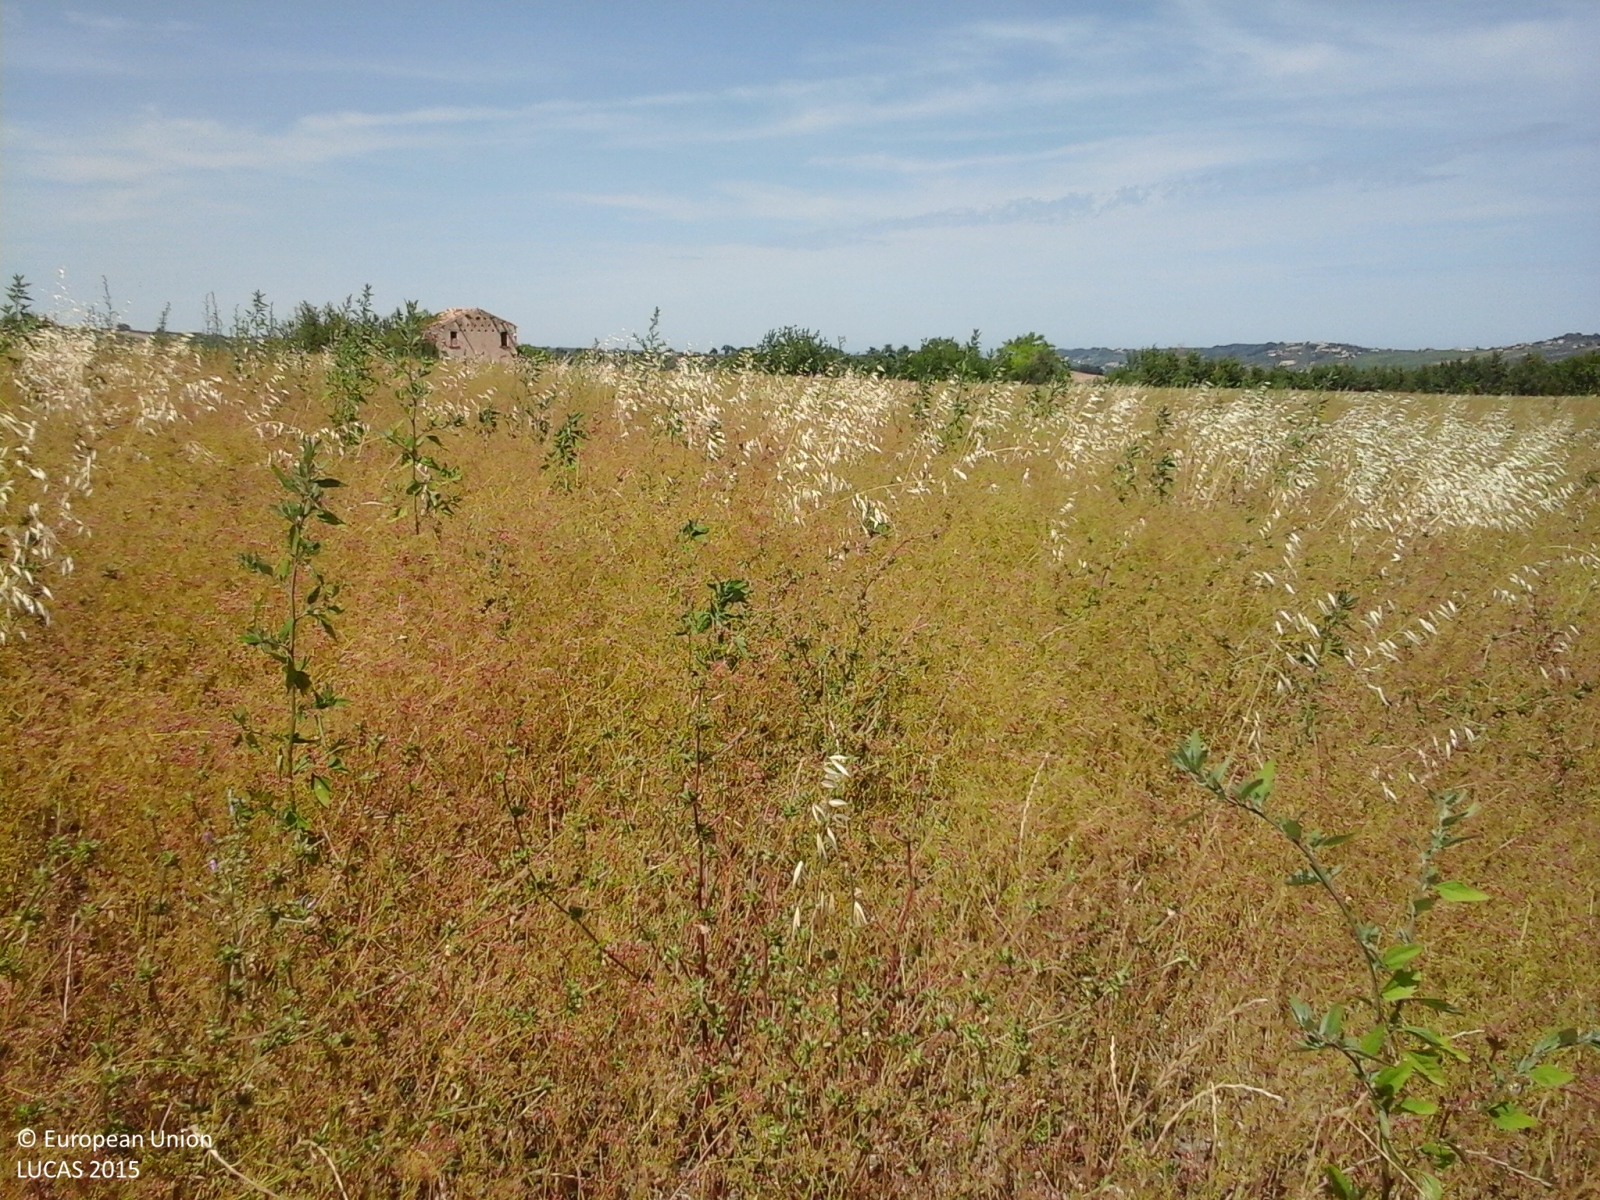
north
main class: Cropland
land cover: Other non-permanent industrial crops
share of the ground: > 75 %
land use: Agriculture (excluding fallow land and kitchen gardens)
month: June
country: IT
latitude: 42.2006
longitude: 14.3102
